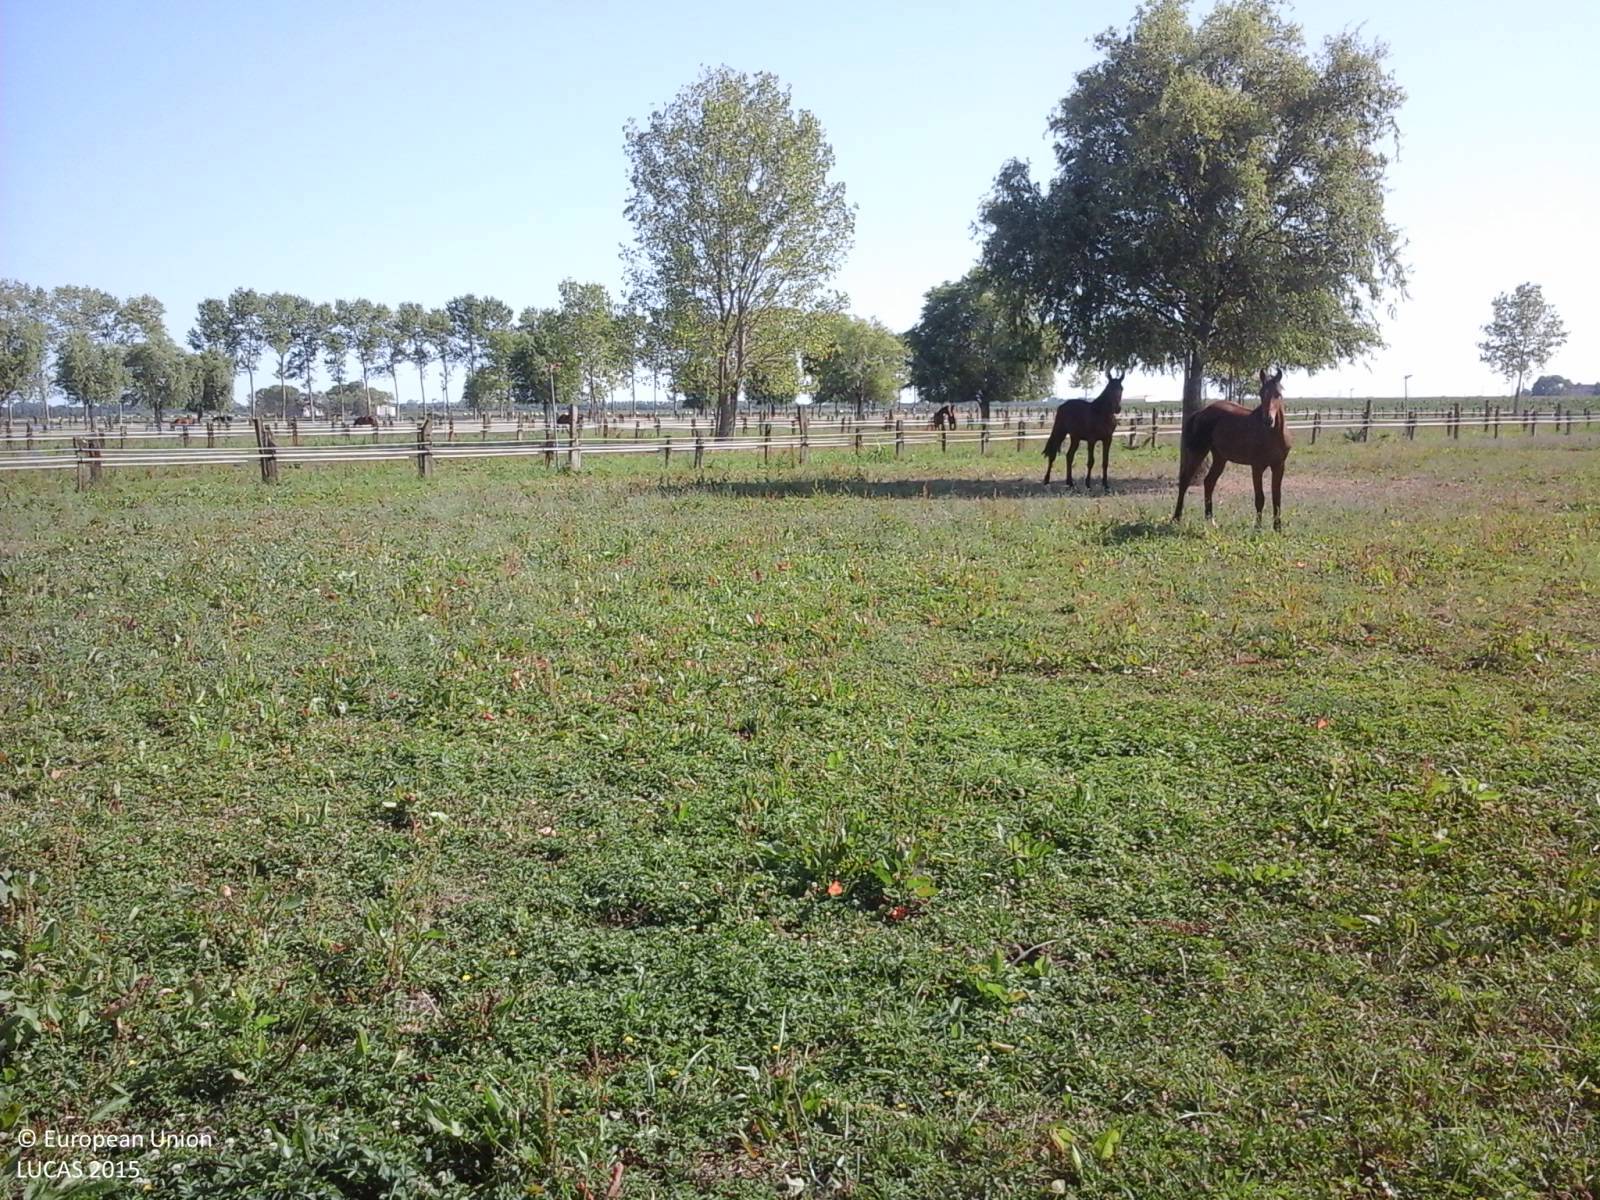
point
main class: Grassland
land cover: Grassland without tree/shrub cover
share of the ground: > 75 %
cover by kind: herbaceous plants 100 %
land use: Agriculture (excluding fallow land and kitchen gardens)
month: July
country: IT
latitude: 45.6771
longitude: 13.0386
